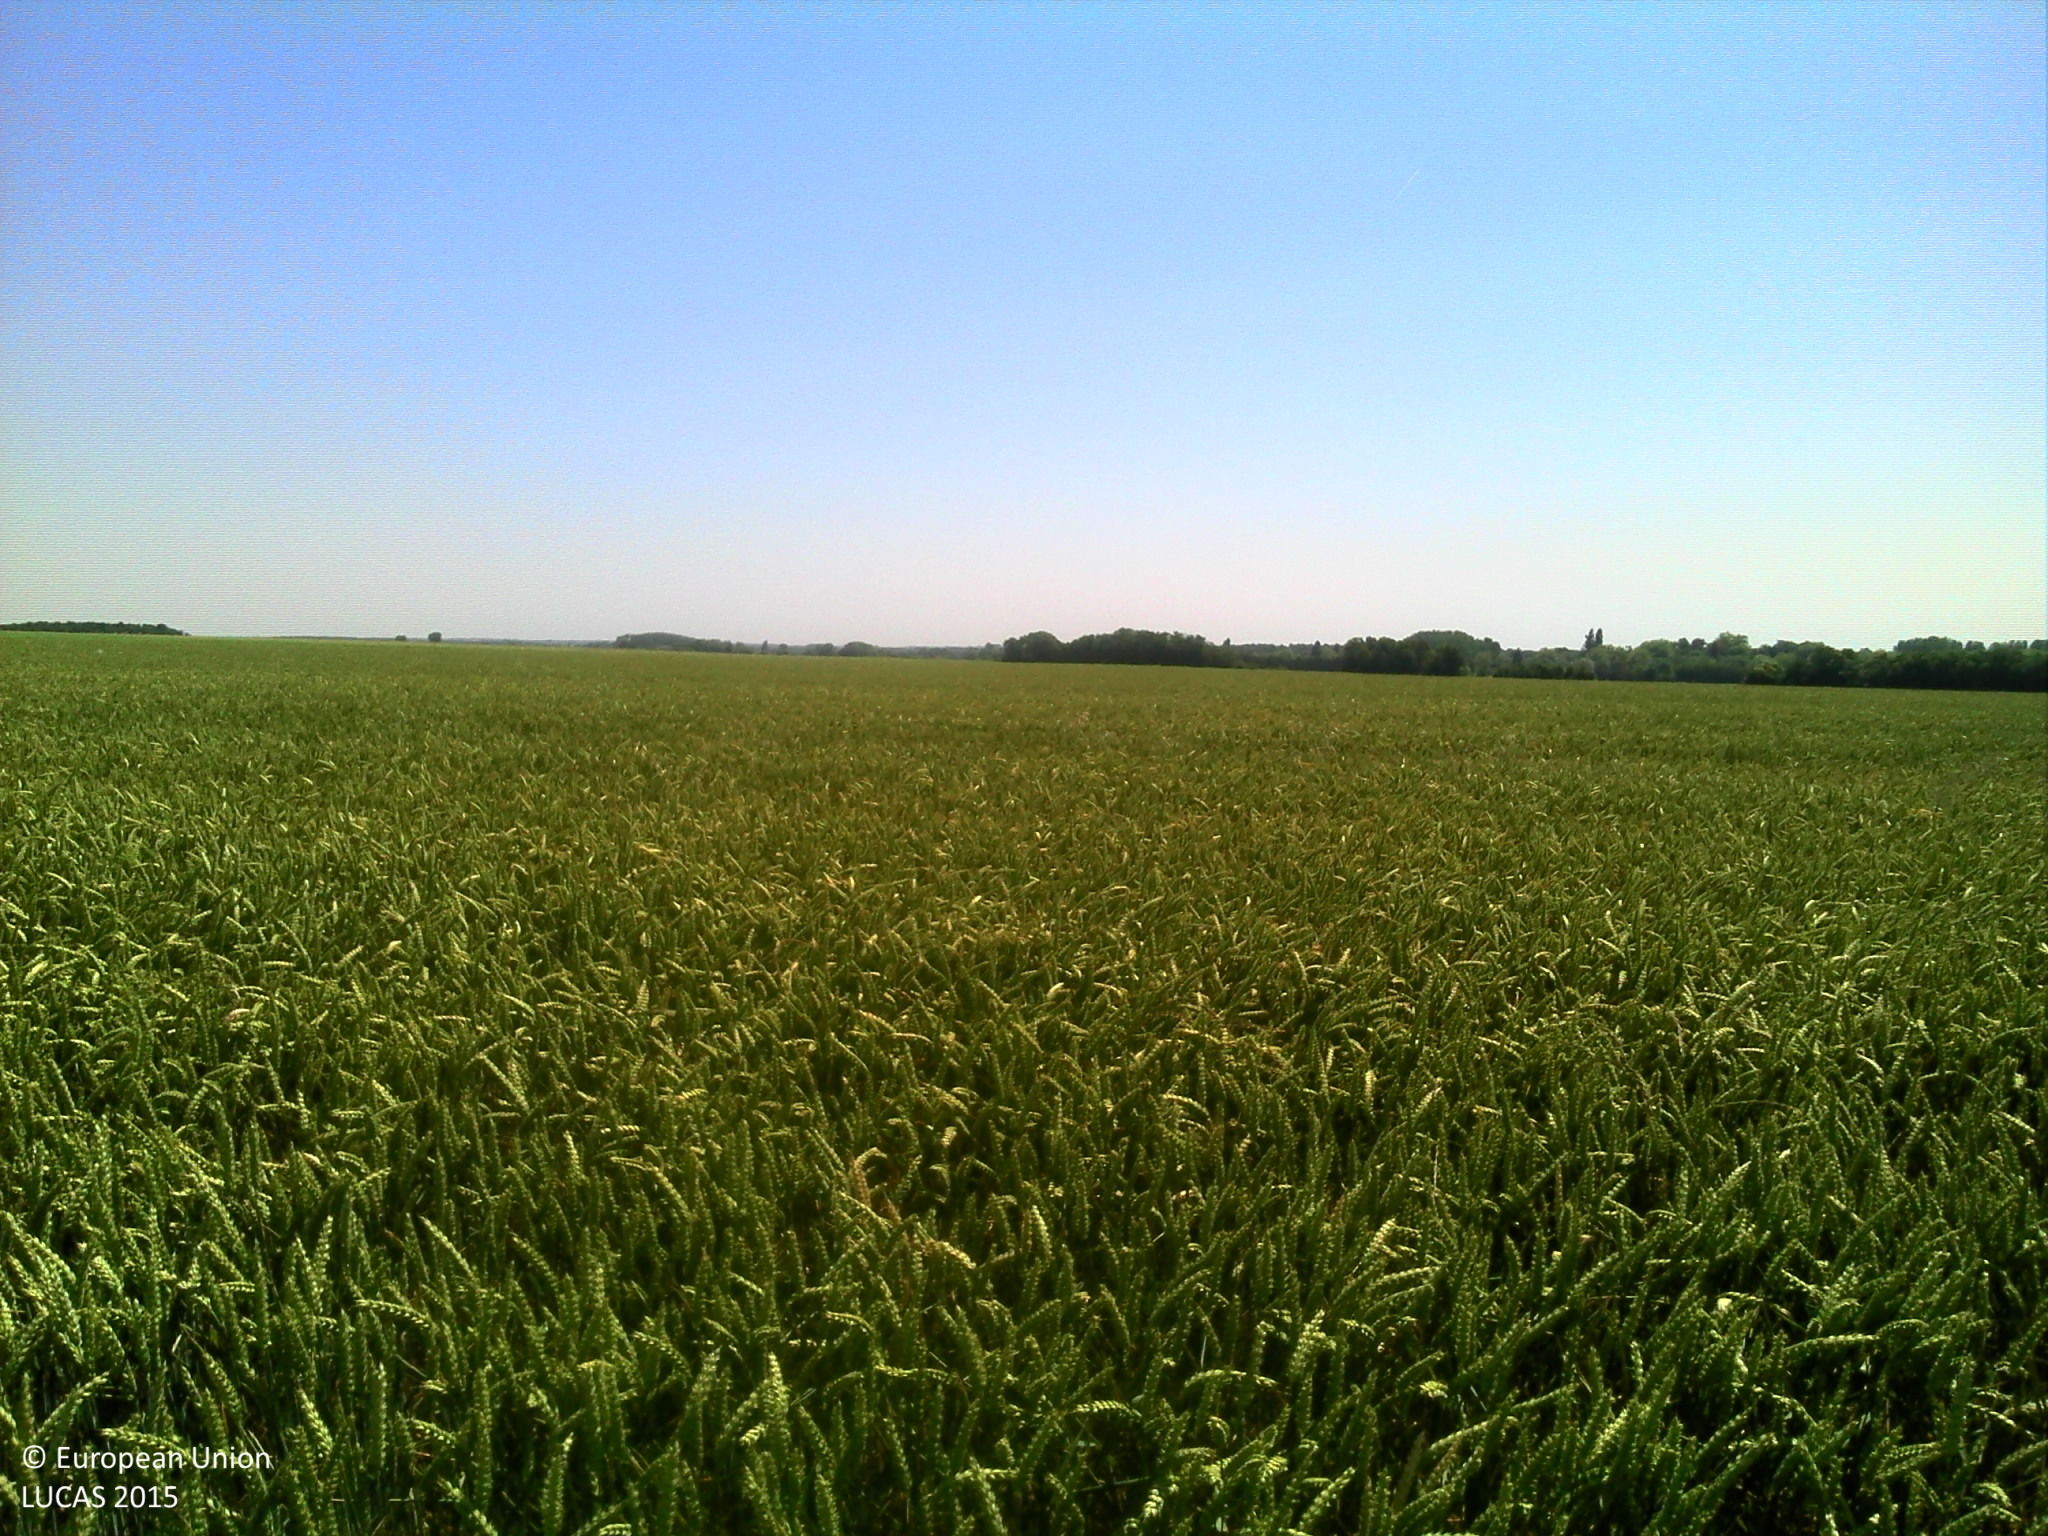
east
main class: Cropland
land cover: Common wheat
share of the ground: > 75 %
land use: Agriculture (excluding fallow land and kitchen gardens)
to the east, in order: Common wheat; Dry pulses; Common wheat
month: June
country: FR
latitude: 46.1486
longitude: -0.9701
